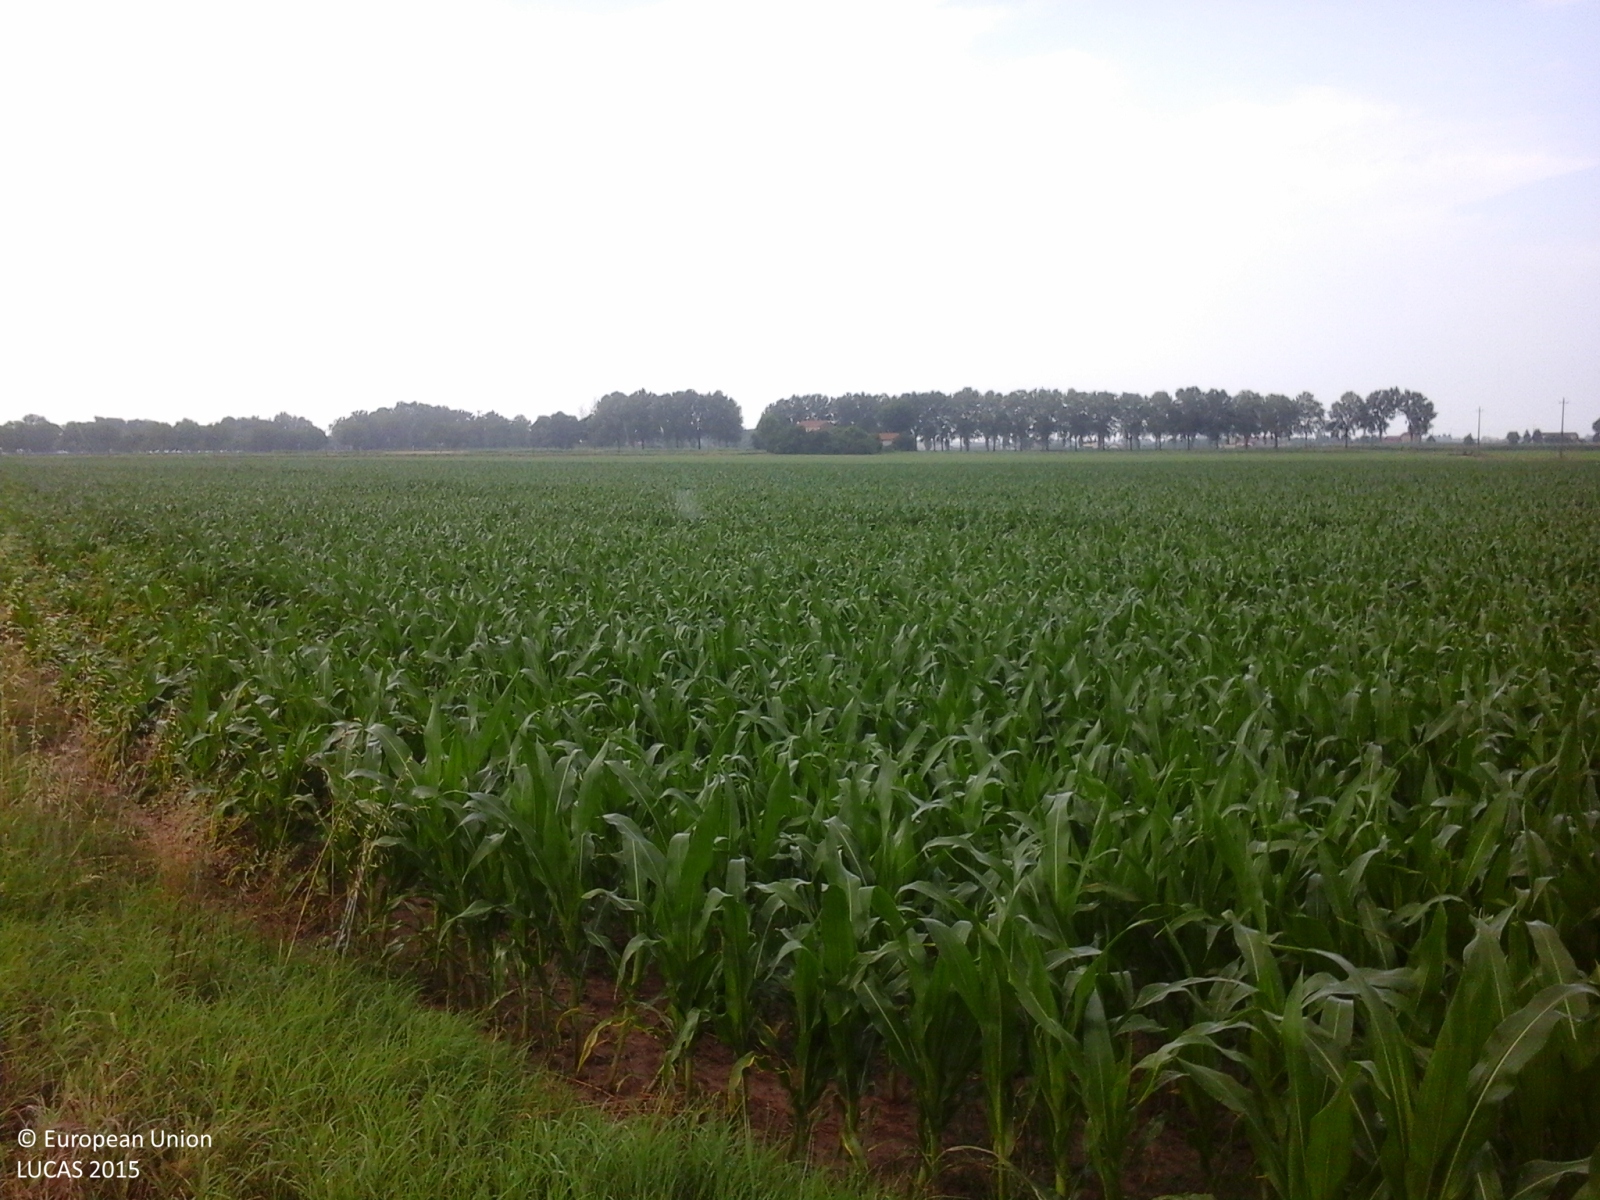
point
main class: Cropland
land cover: Maize
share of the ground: > 75 %
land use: Agriculture (excluding fallow land and kitchen gardens)
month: June
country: IT
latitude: 45.6308
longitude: 12.7540
